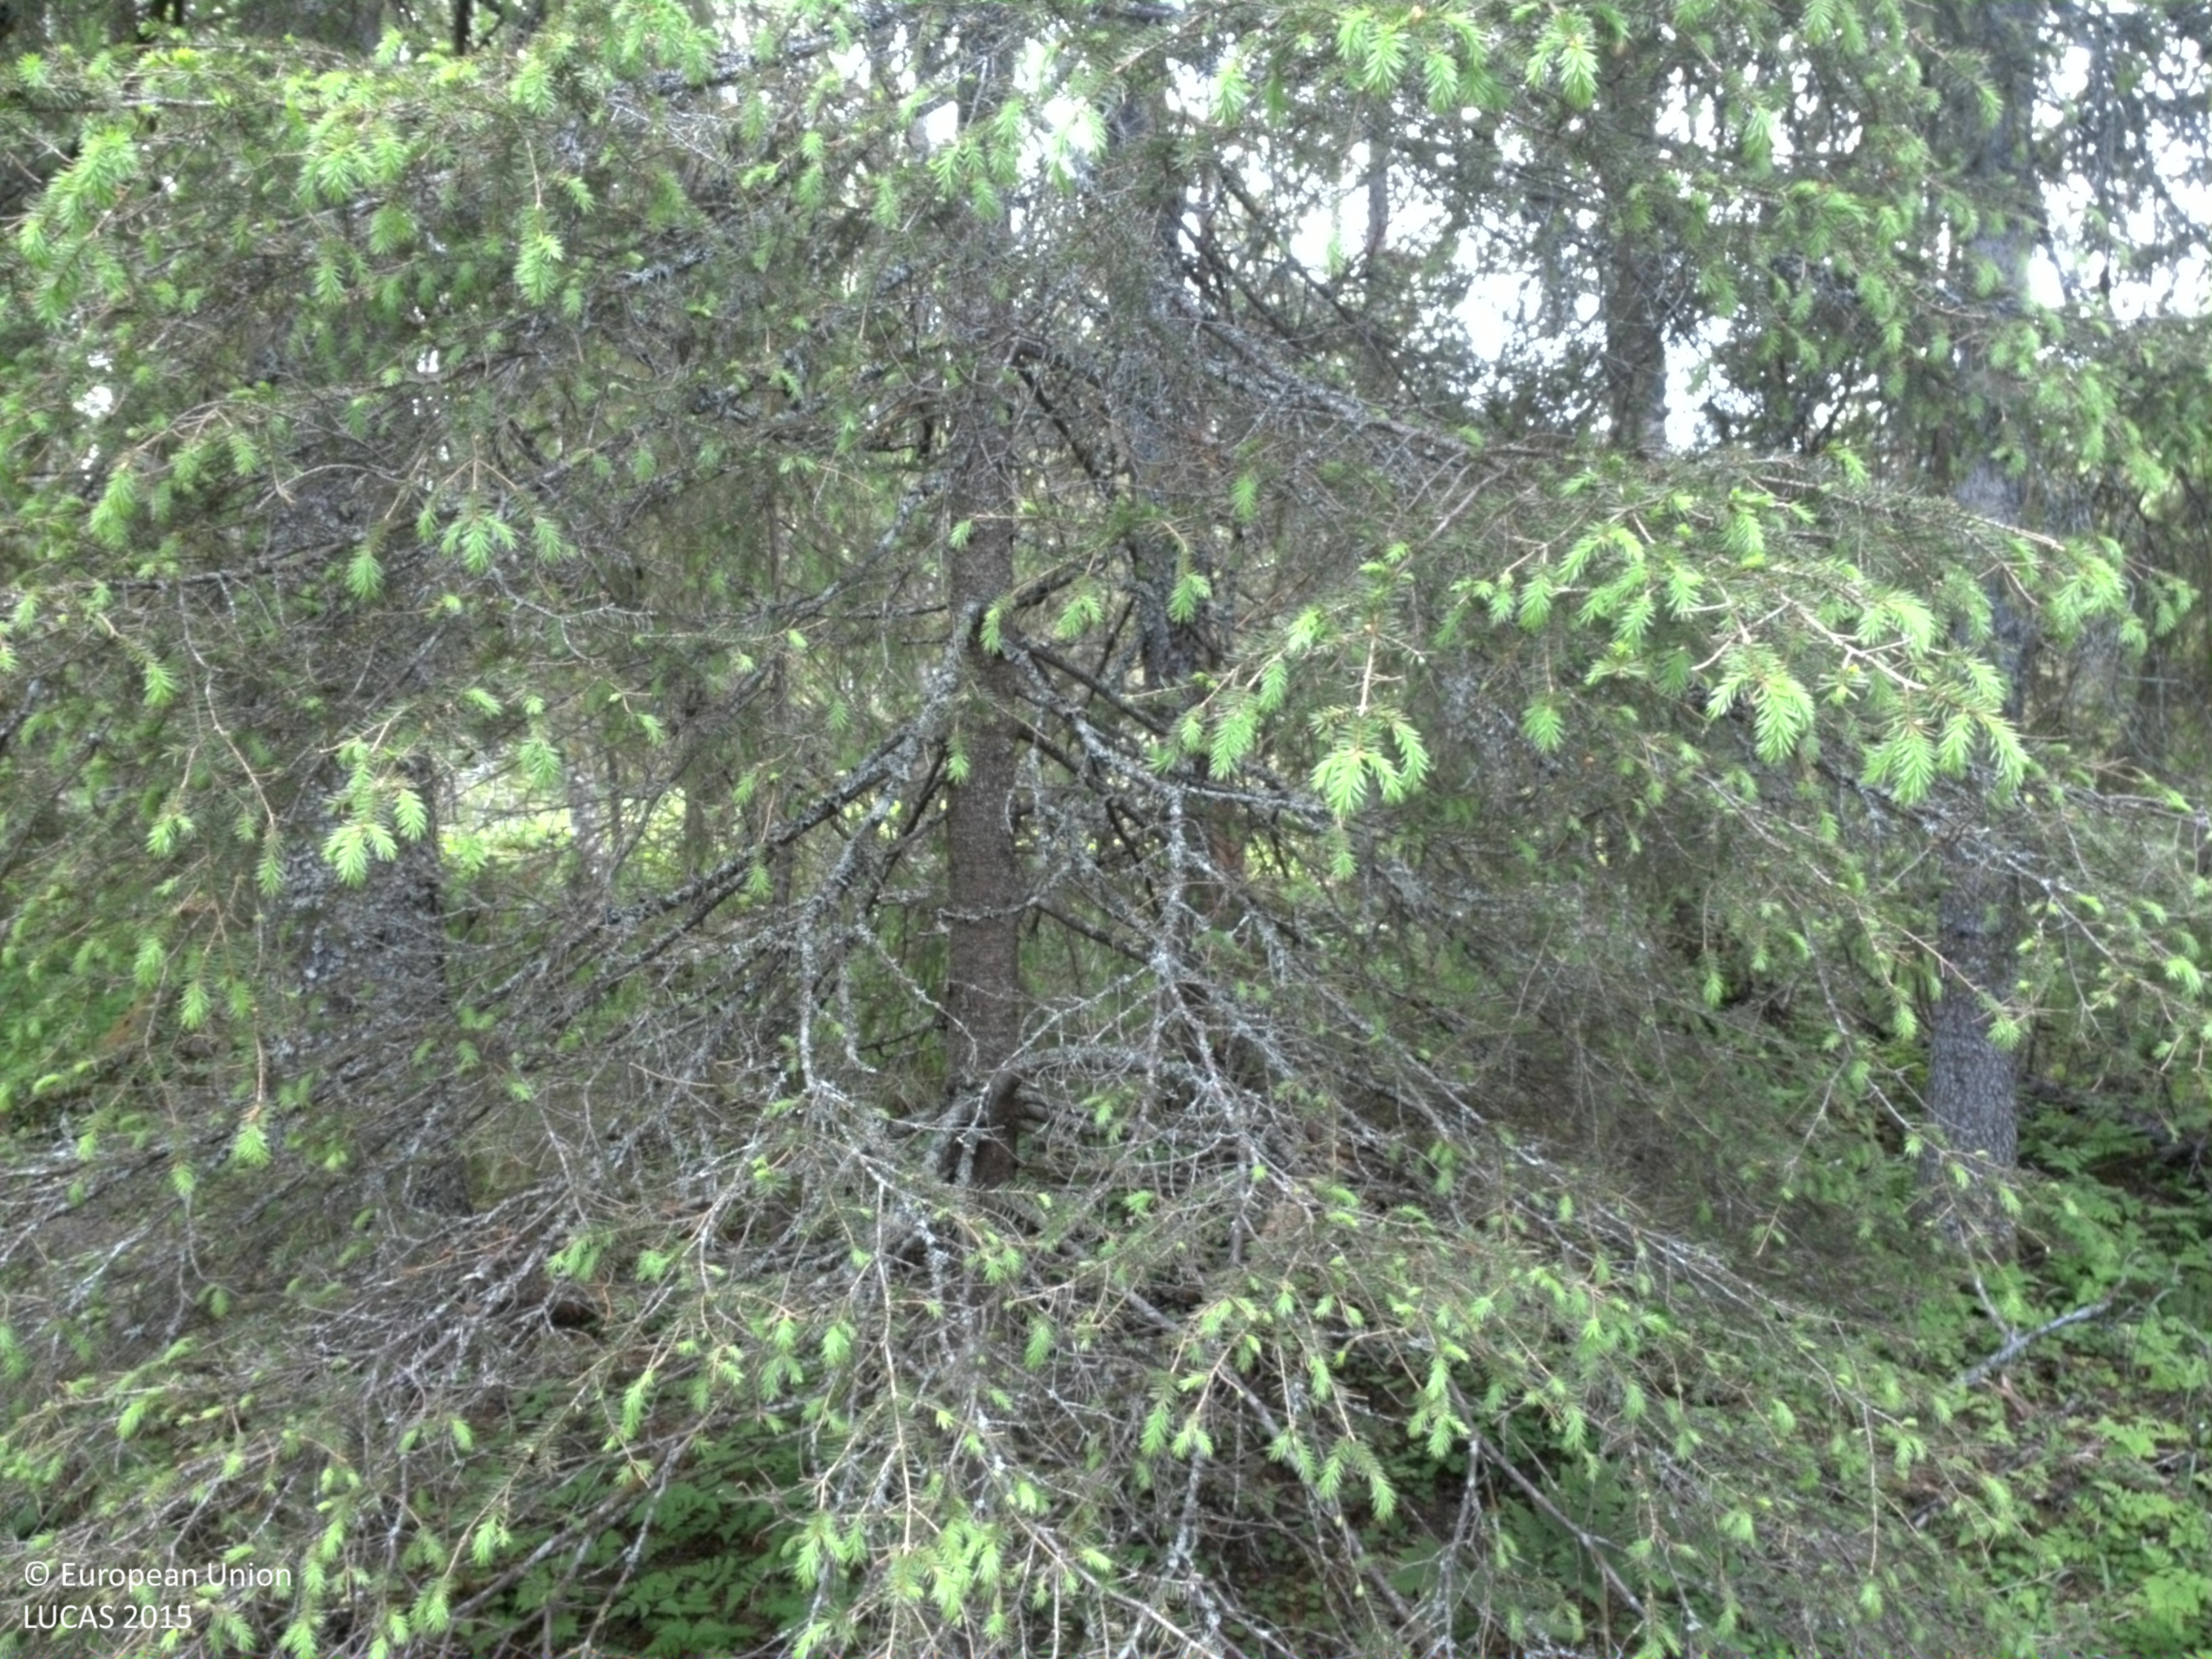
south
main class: Woodland
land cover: Spruce dominated coniferous woodland
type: boreal forest
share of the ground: 50 - 75 %
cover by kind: coniferous forest trees 70 %, herbaceous plants 25 %, broadleaved forest trees 5 %
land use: Forestry
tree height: > 5 m
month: July
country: SE
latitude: 64.5175
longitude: 18.1128
